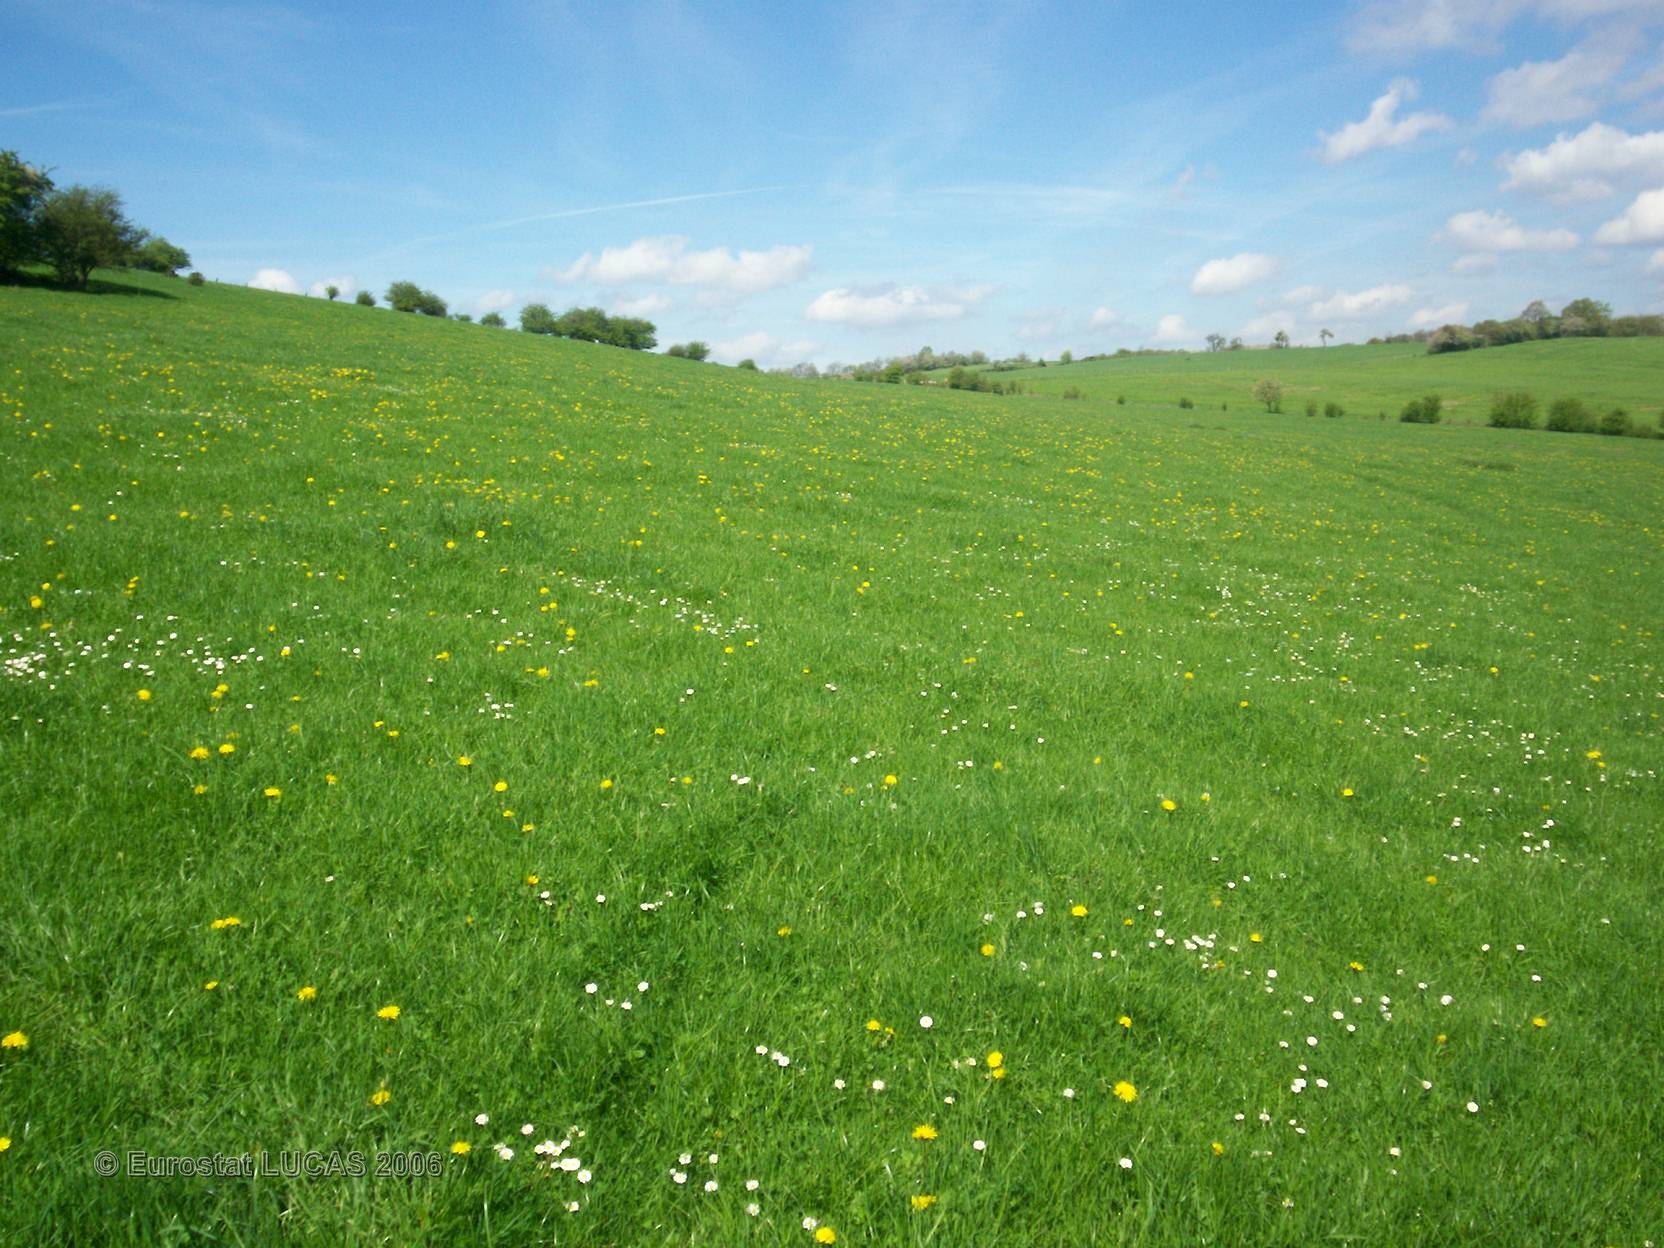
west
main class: Grassland
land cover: Grassland without tree/shrub cover
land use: Agriculture (excluding fallow land and kitchen gardens)
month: May
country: FR
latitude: 49.1129
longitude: 6.7808
